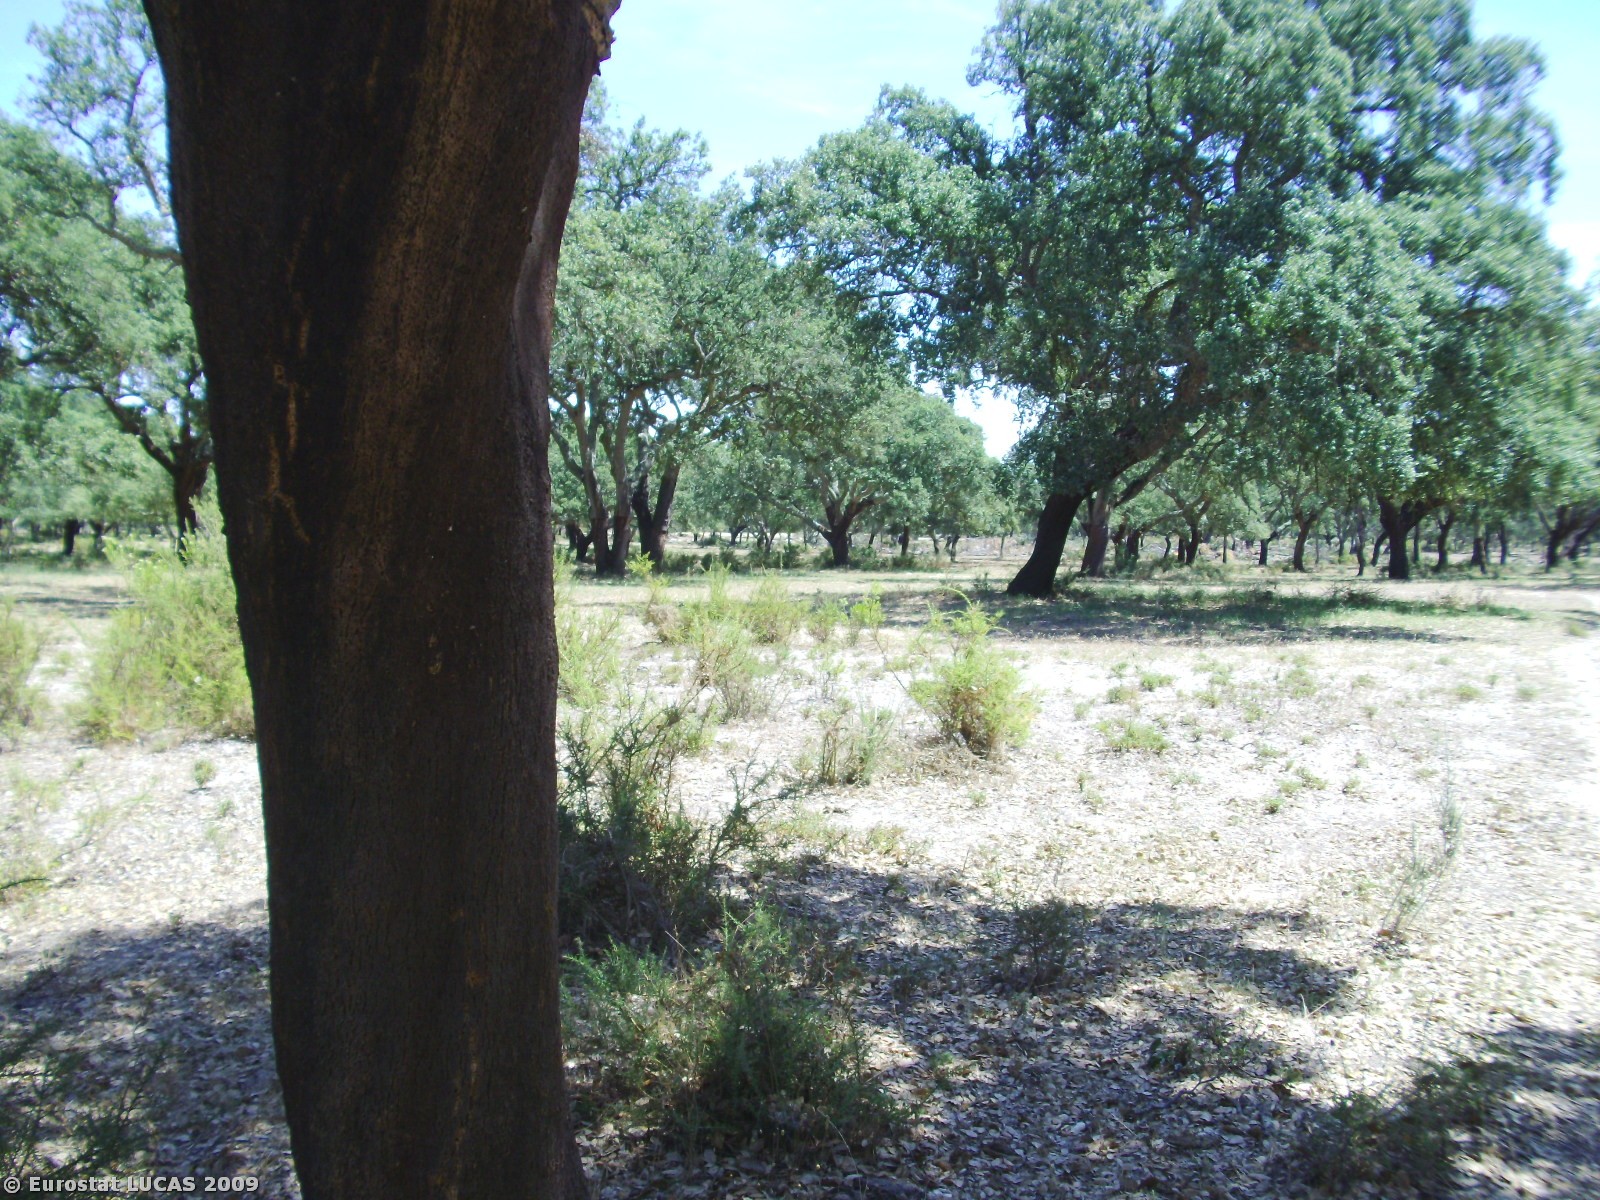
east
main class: Woodland
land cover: Broadleaved woodland
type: broadleaved evergreen forest
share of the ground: 25 - 50 %
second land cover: Spontaneously vegetated surfaces
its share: 50 - 75 %
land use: Forestry
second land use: Fallow land
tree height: > 5 m
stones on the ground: 10 - 25 %
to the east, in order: Broadleaved woodland; Spontaneously vegetated surfaces; Broadleaved woodland
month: August
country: PT
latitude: 38.6960
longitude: -8.8655
